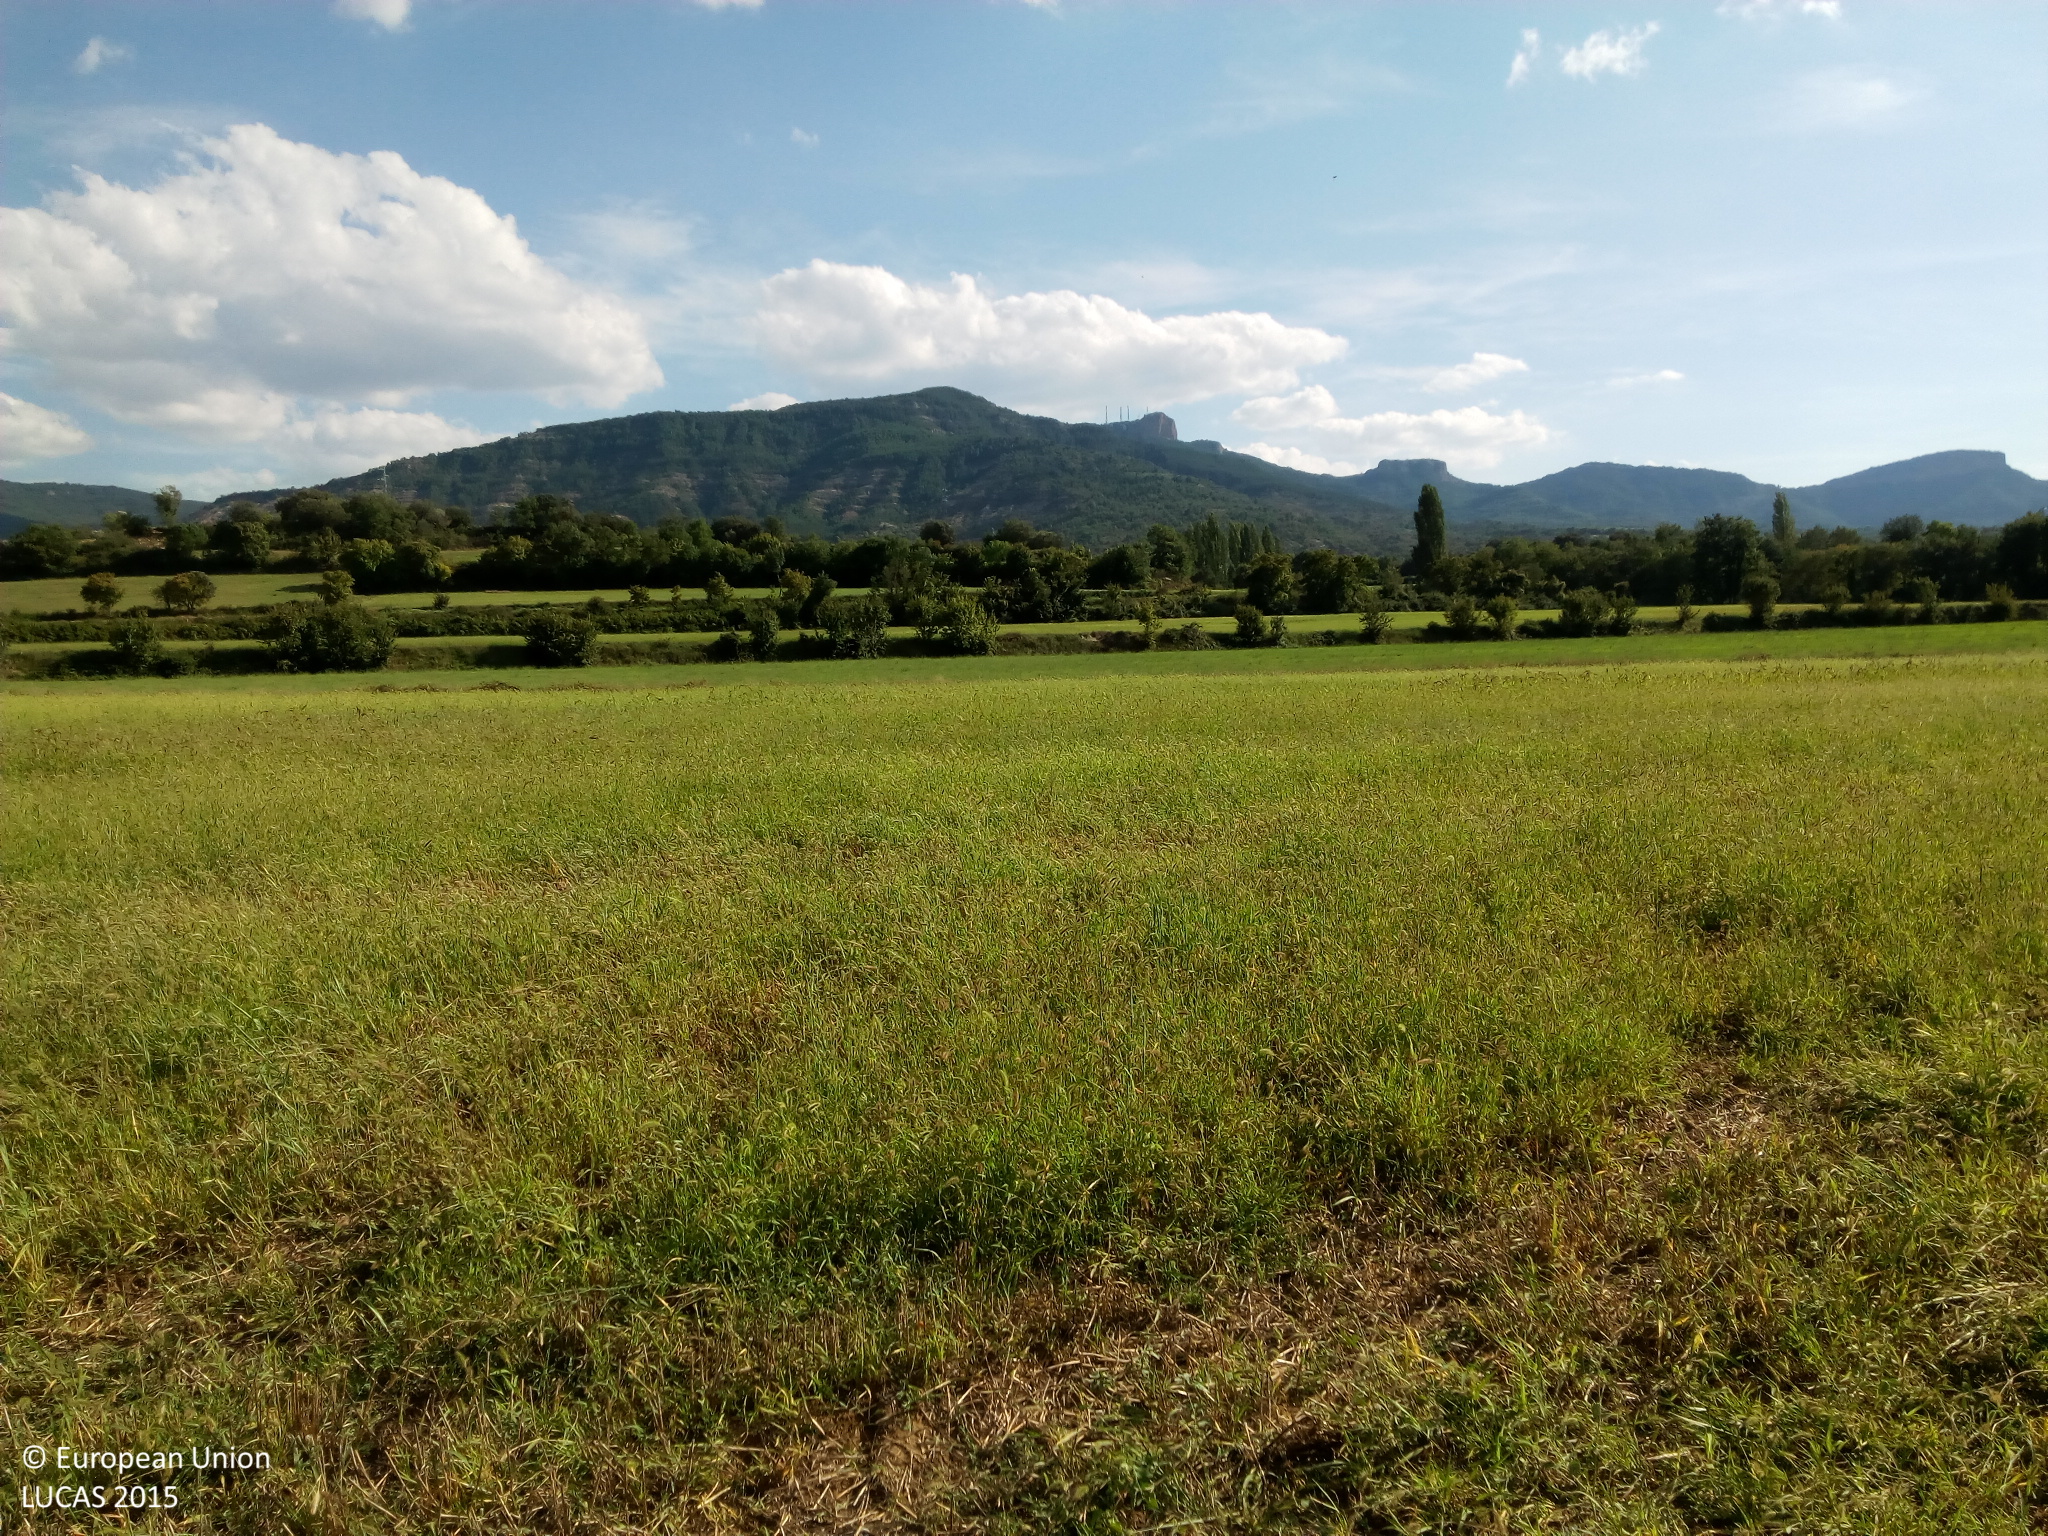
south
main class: Cropland
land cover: Temporary grasslands
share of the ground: > 75 %
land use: Agriculture (excluding fallow land and kitchen gardens)
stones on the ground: < 10 %
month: August
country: ES
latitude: 42.2042
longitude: 0.4748
